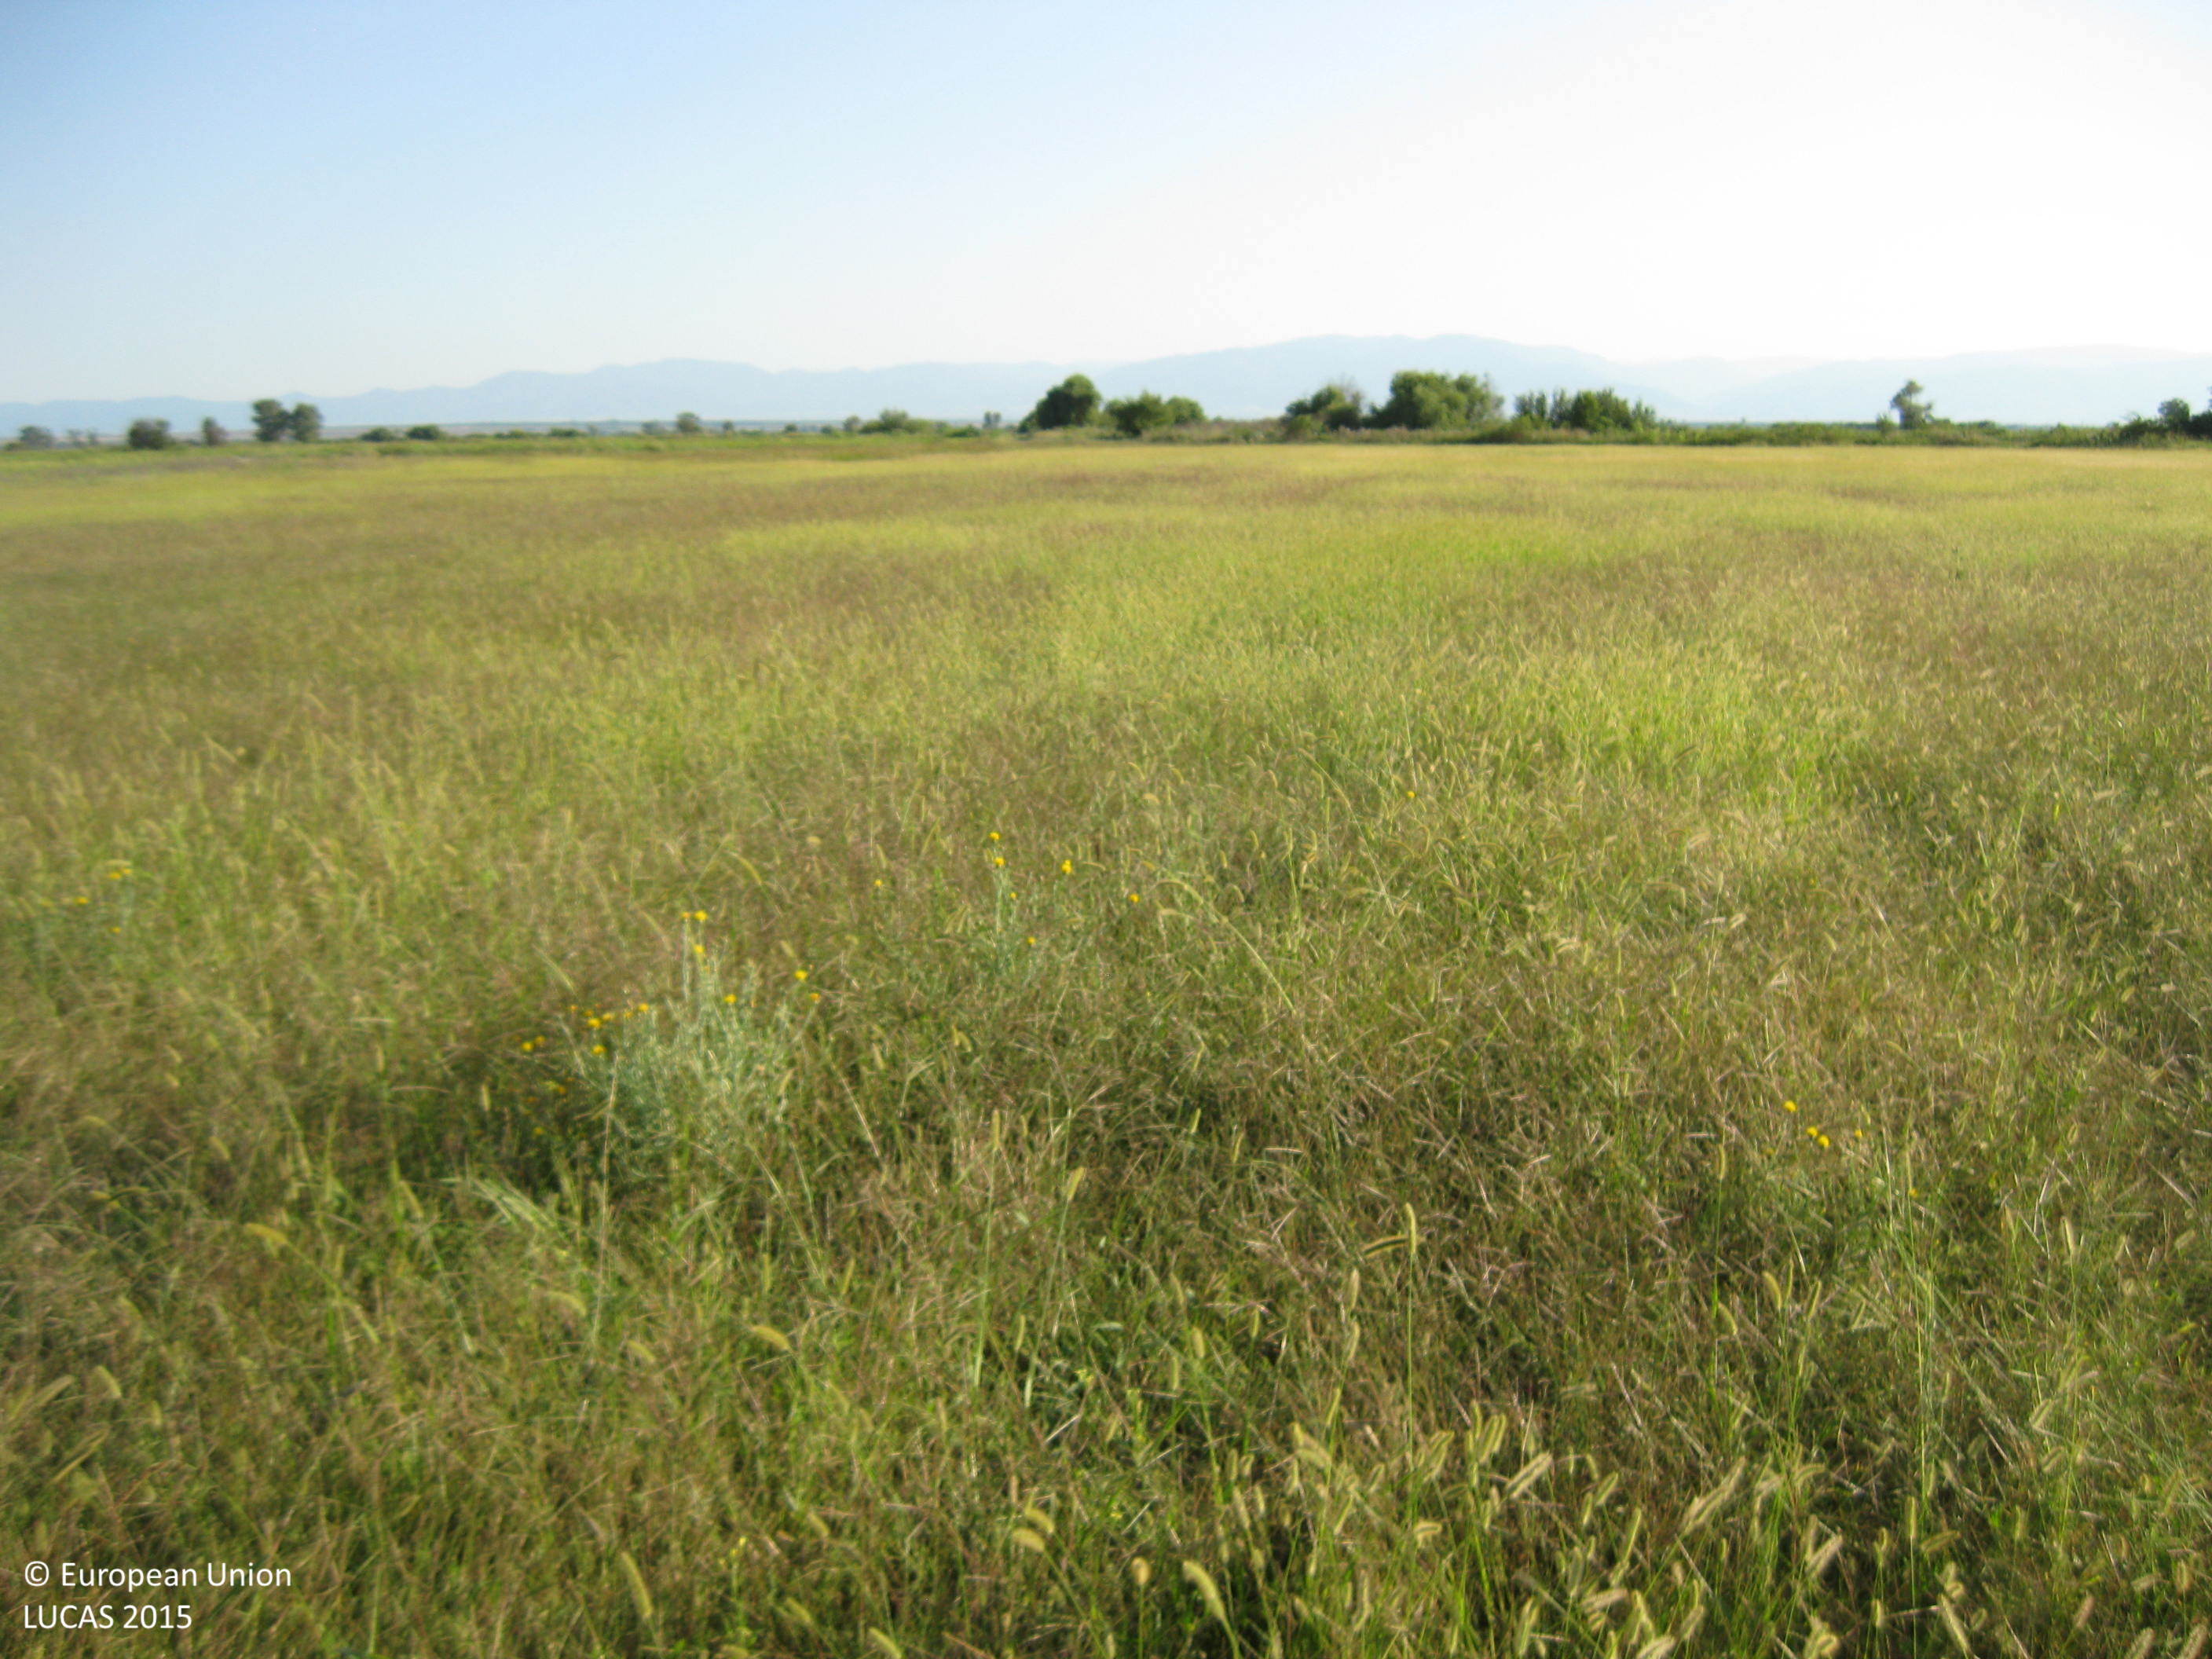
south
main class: Cropland
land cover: Mixed cereals for fodder
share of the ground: 25 - 50 %
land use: Agriculture (excluding fallow land and kitchen gardens)
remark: Harvested field
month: August
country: BG
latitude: 42.2094
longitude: 24.9915
